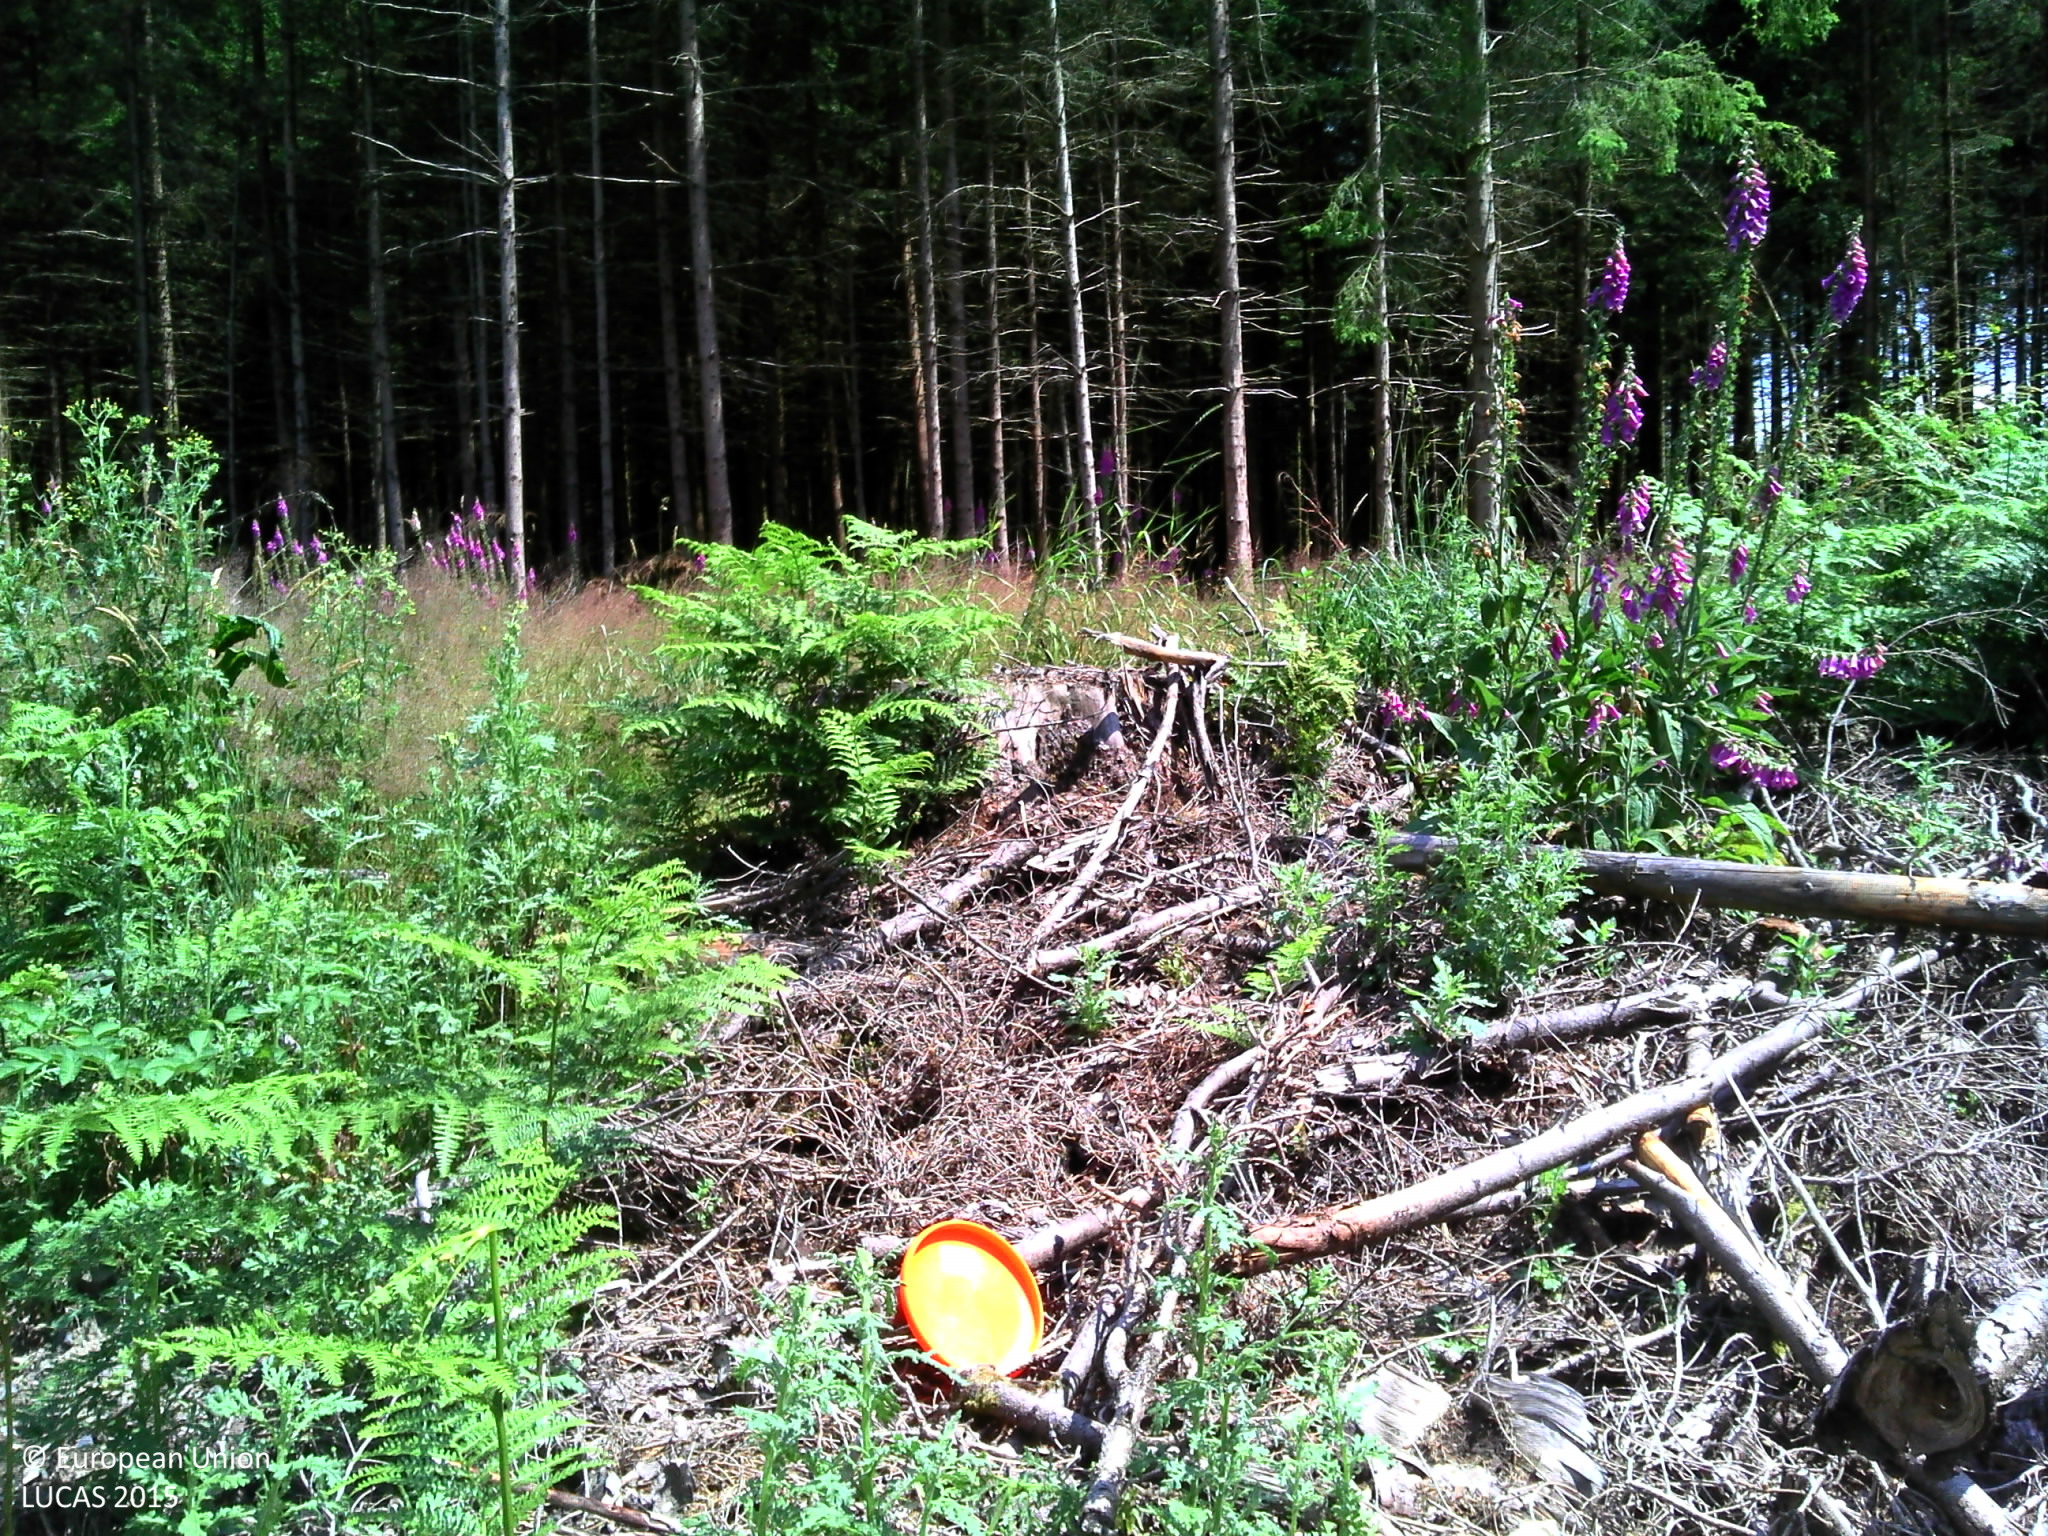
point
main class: Grassland
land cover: Spontaneously vegetated surfaces
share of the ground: > 75 %
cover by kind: herbaceous plants 60 %, unconsolidated bare surface 40 %
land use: Forestry
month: July
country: BE
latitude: 49.8704
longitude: 5.2812
